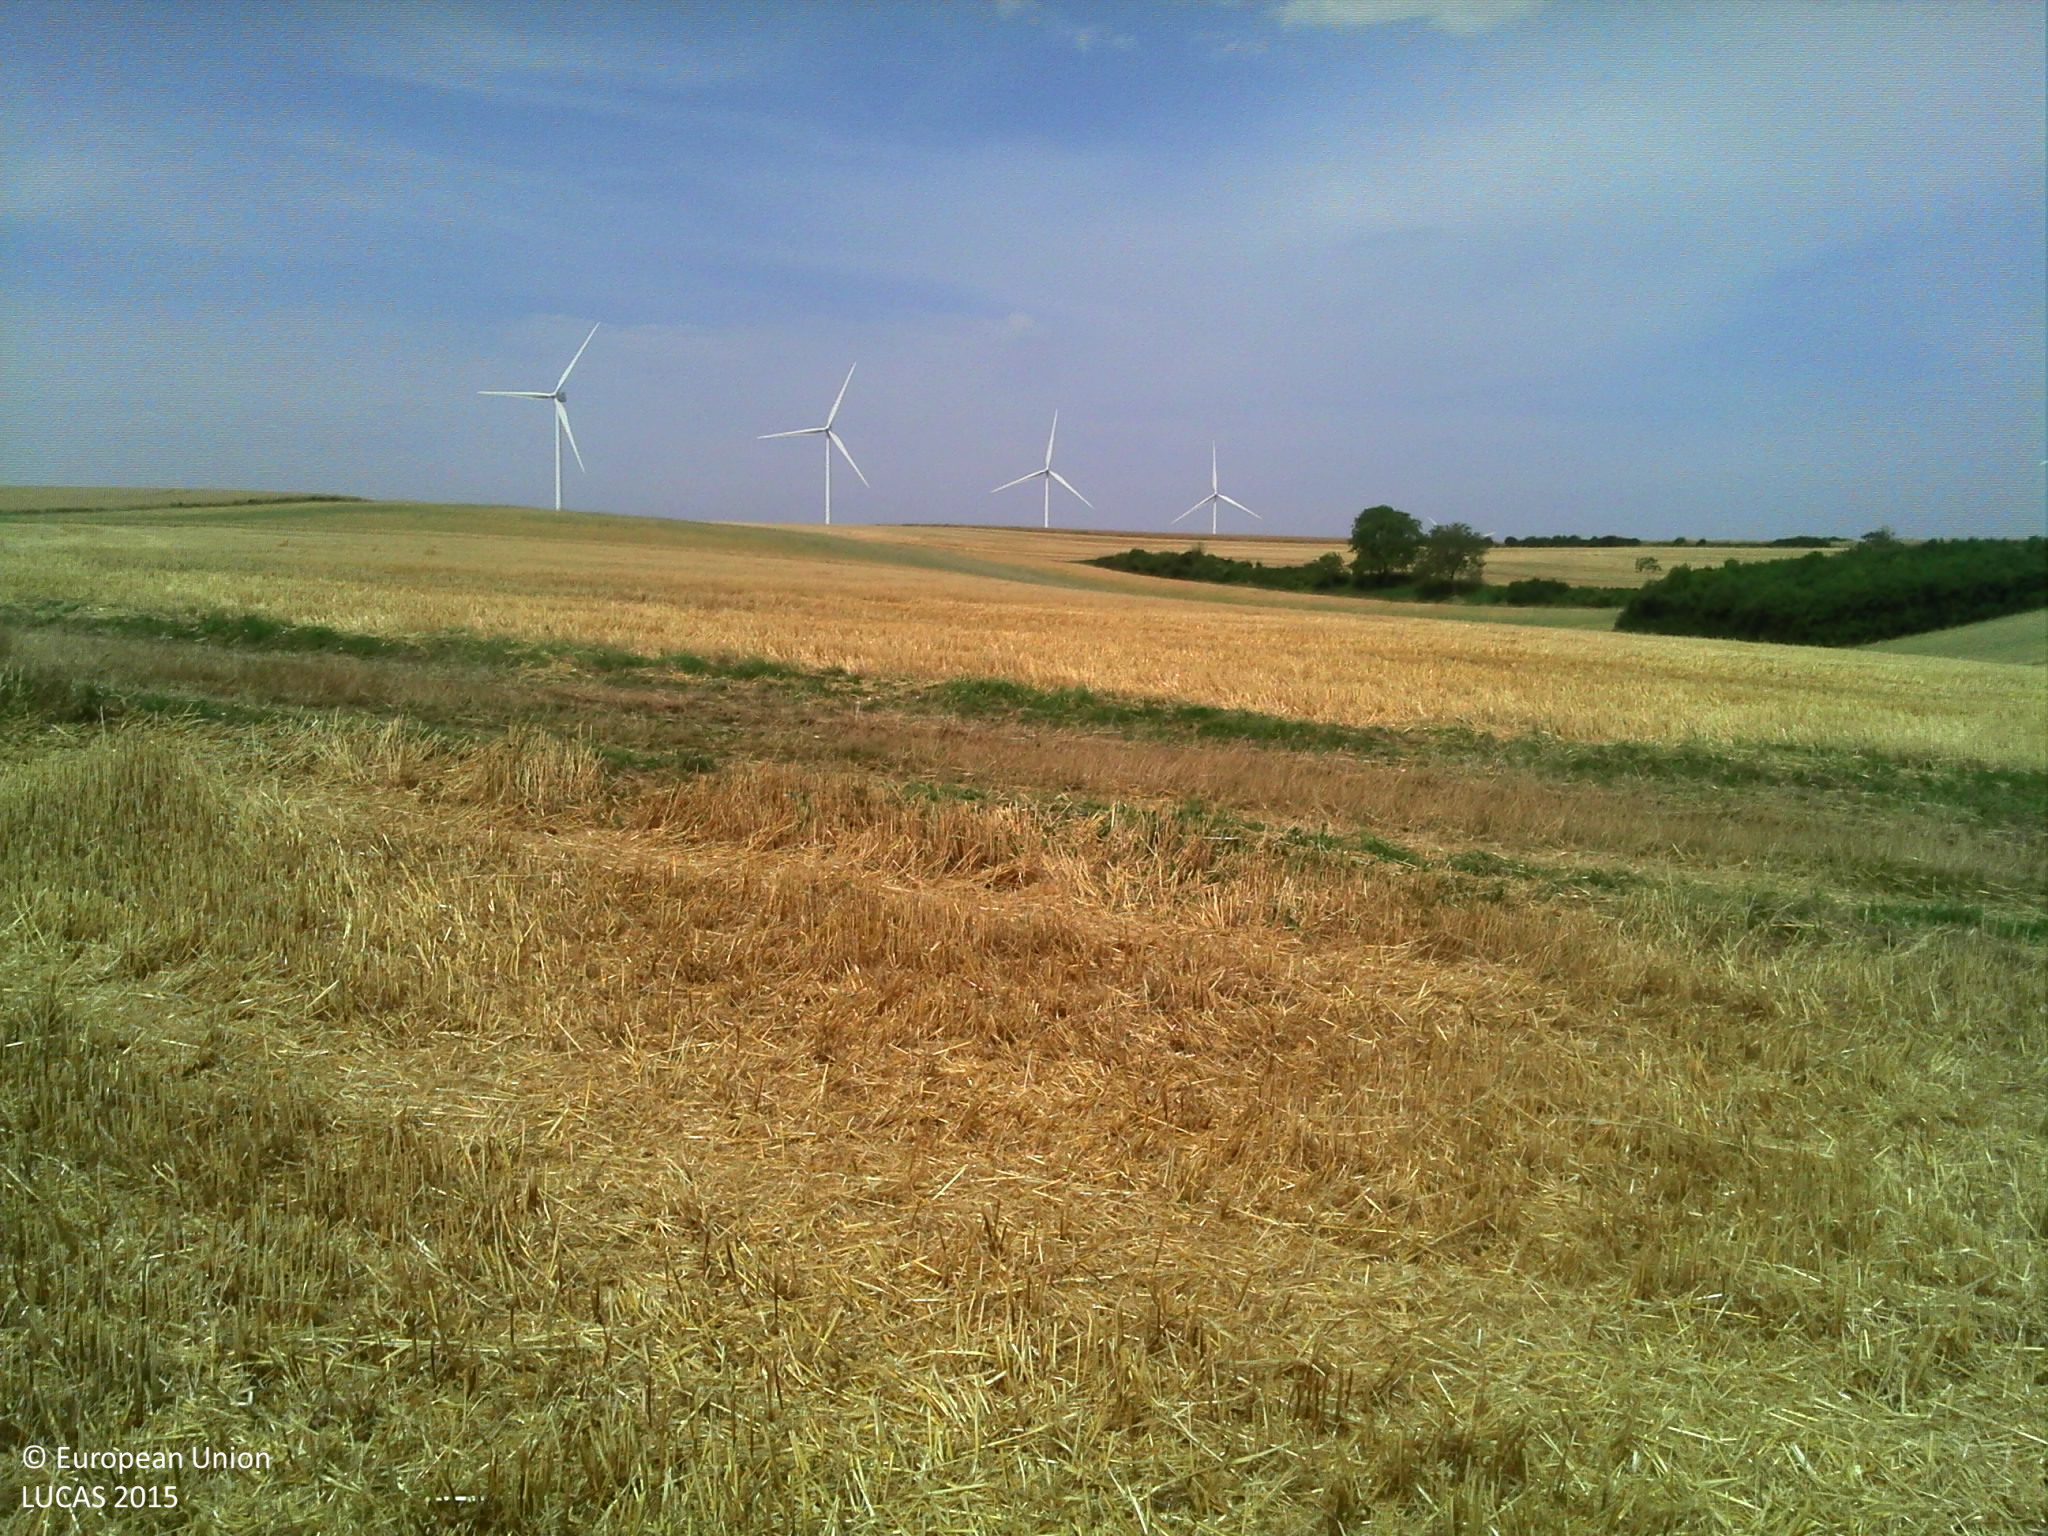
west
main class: Cropland
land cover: Barley
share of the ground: > 75 %
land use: Agriculture (excluding fallow land and kitchen gardens)
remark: Harvested field
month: July
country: FR
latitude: 47.6517
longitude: 3.4855
